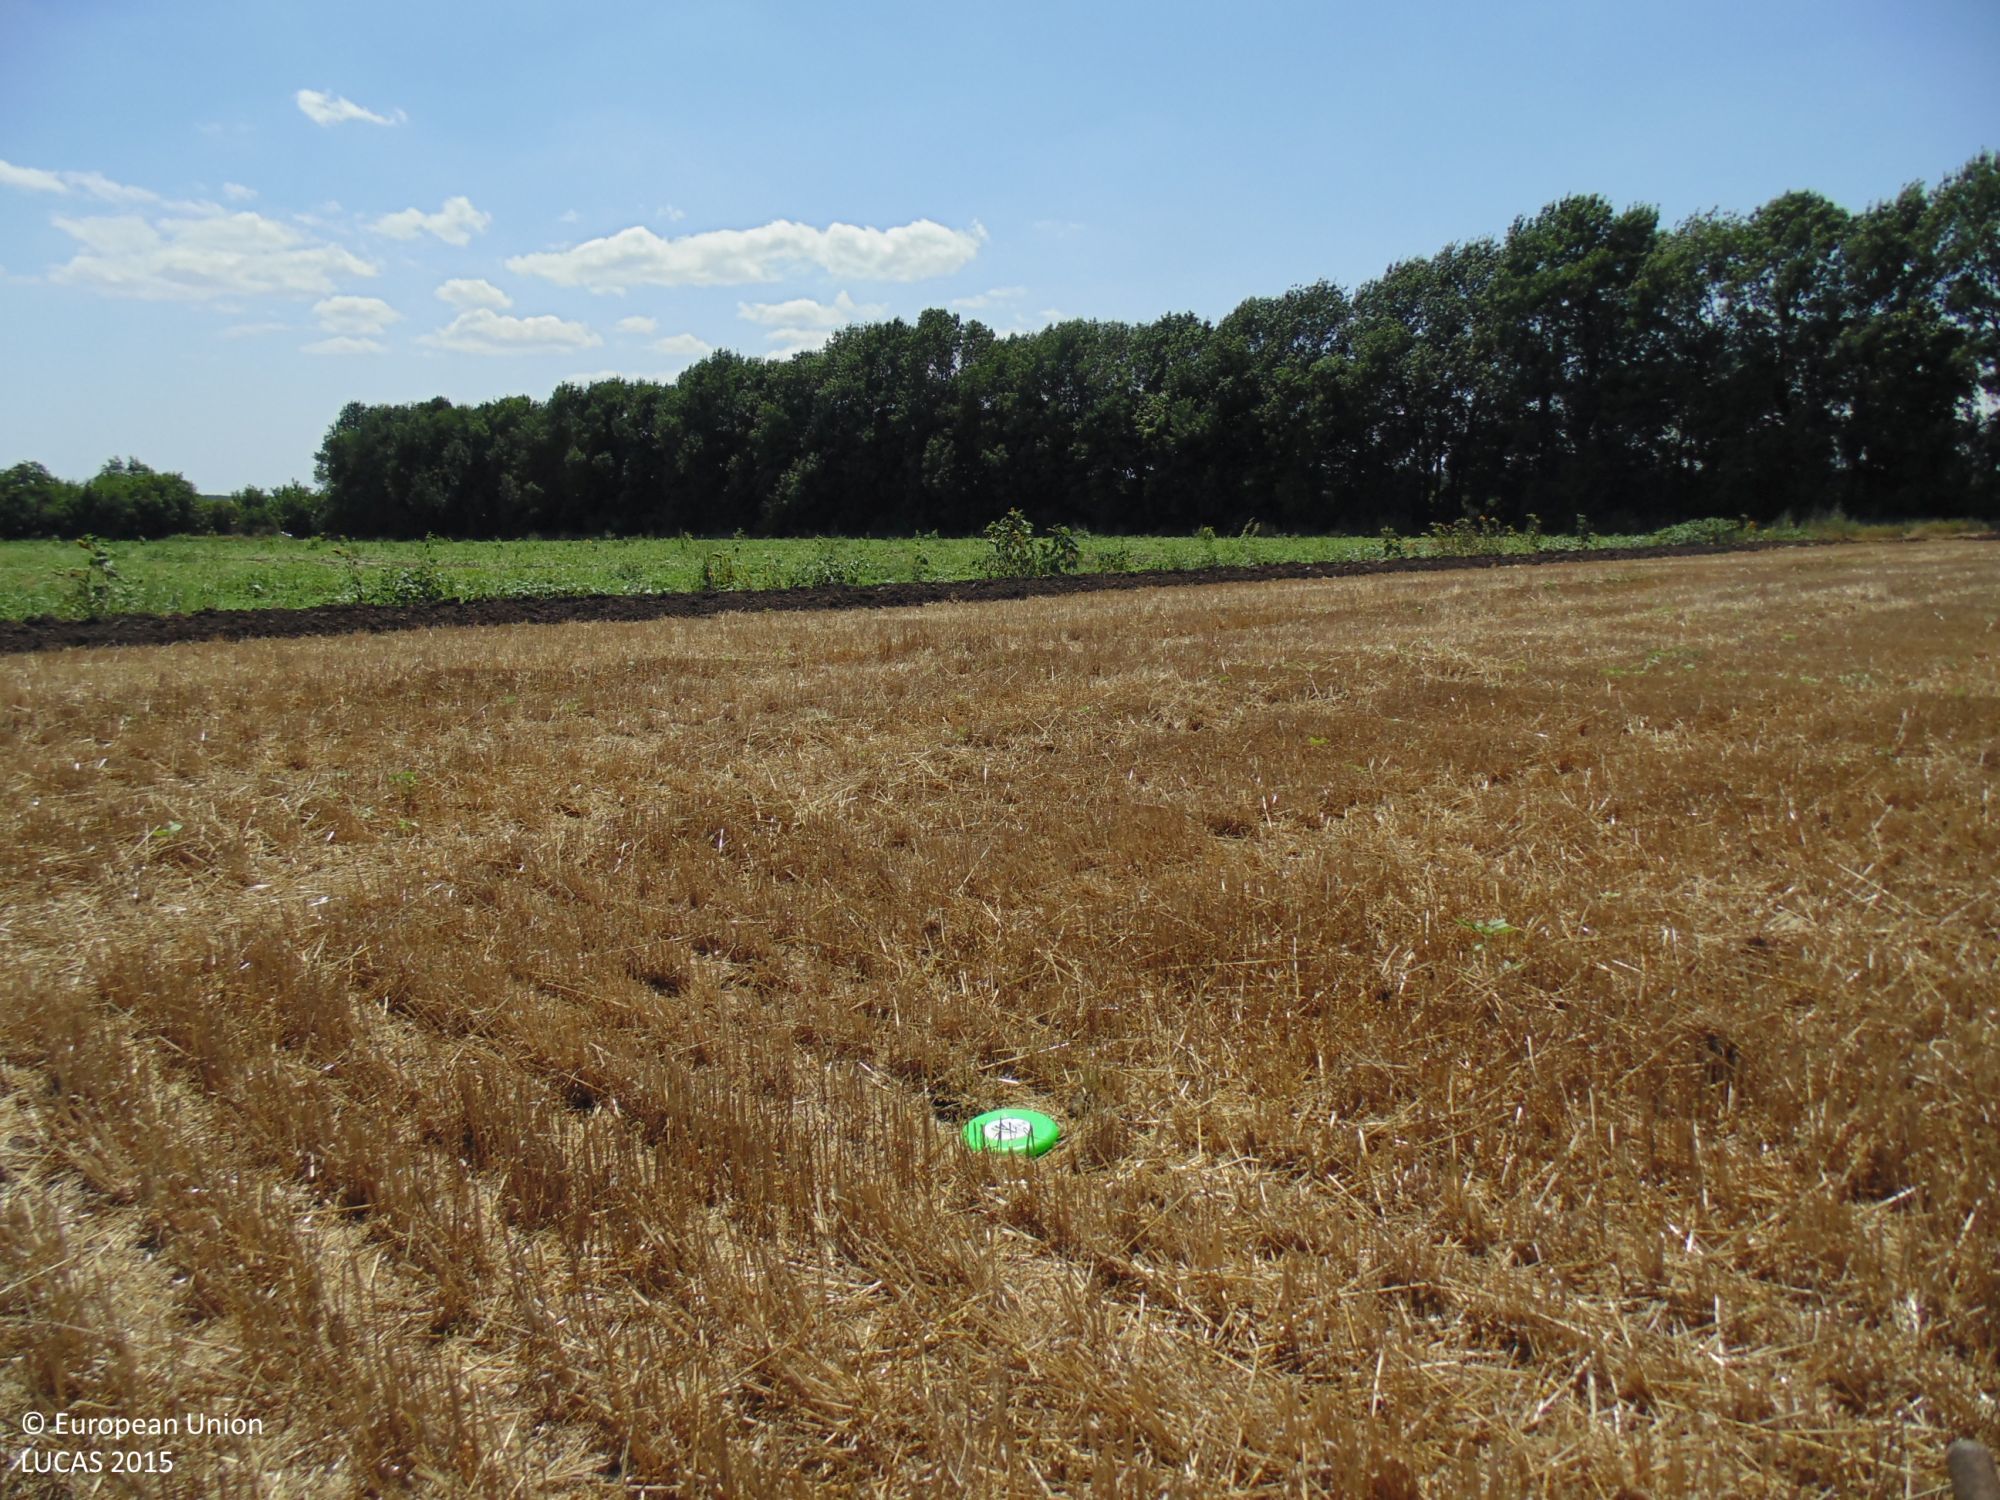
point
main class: Cropland
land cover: Common wheat
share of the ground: > 75 %
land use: Agriculture (excluding fallow land and kitchen gardens)
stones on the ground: < 10 %
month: August
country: BG
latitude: 43.5873
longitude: 28.1215
